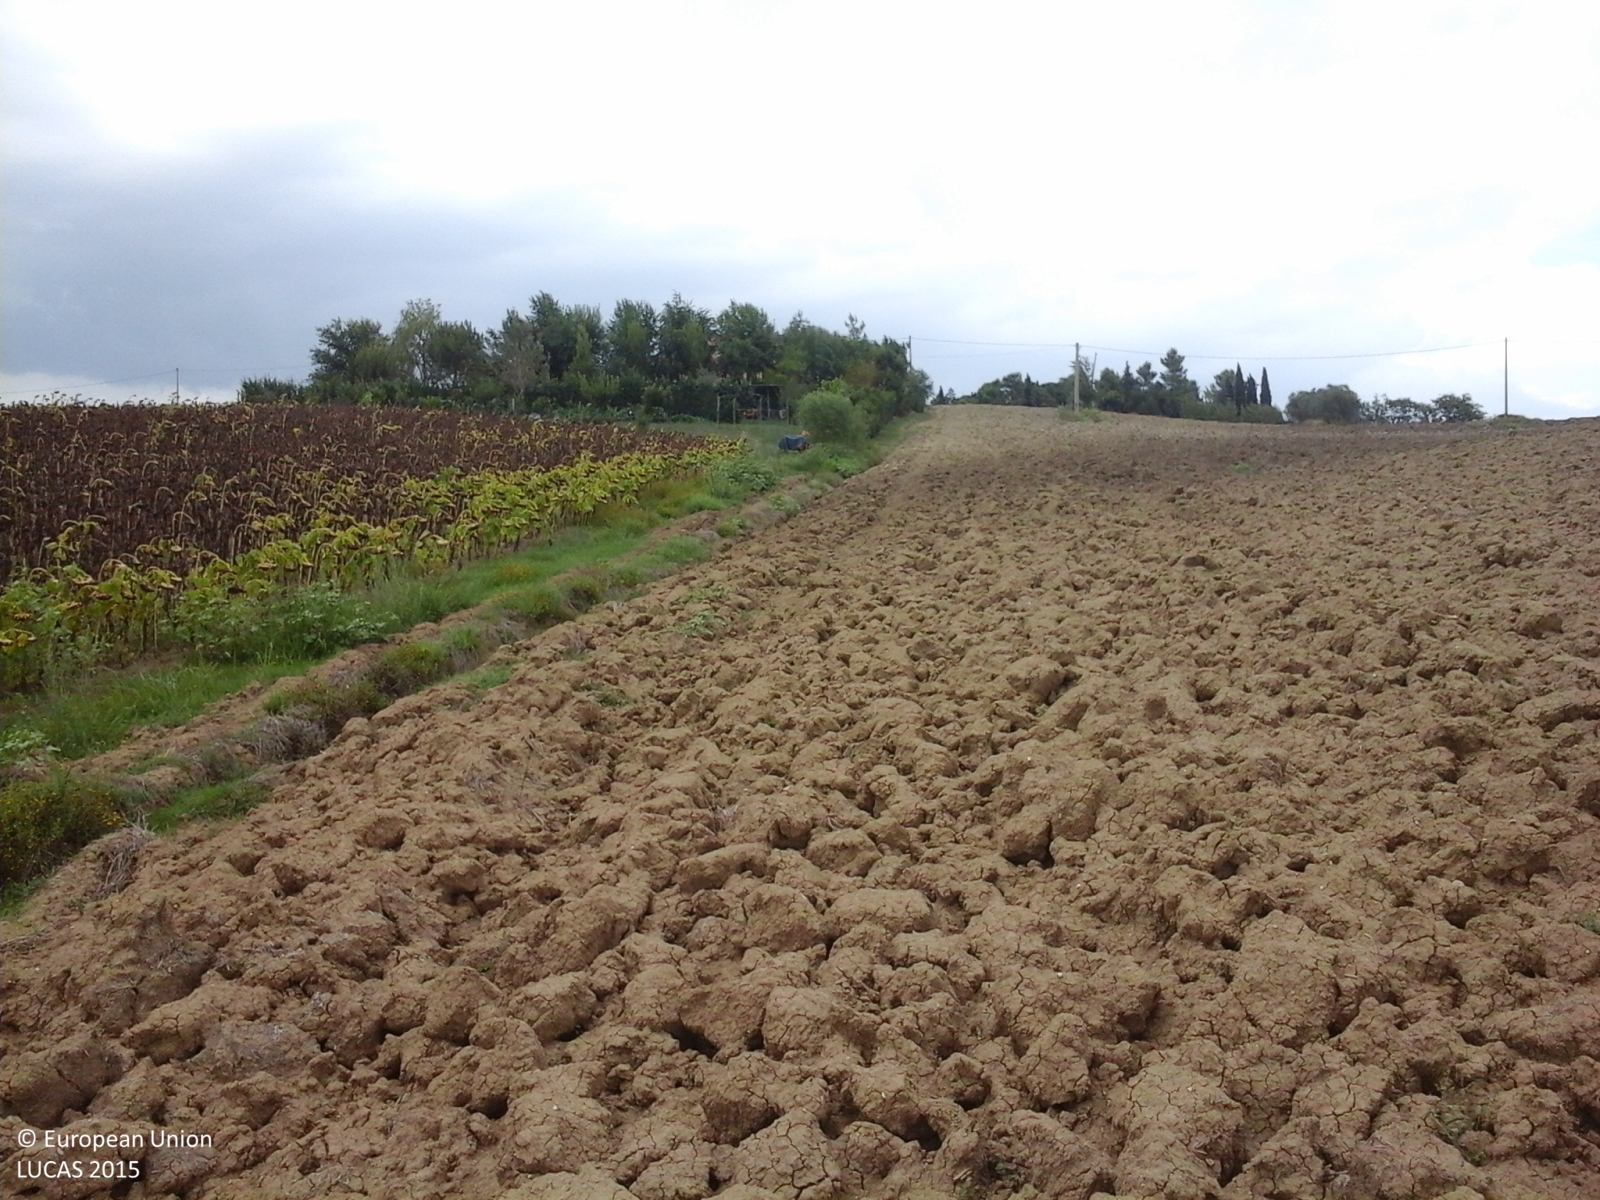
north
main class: Cropland
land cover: Sunflower
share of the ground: > 75 %
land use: Agriculture (excluding fallow land and kitchen gardens)
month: August
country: IT
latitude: 43.4709
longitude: 13.1936
